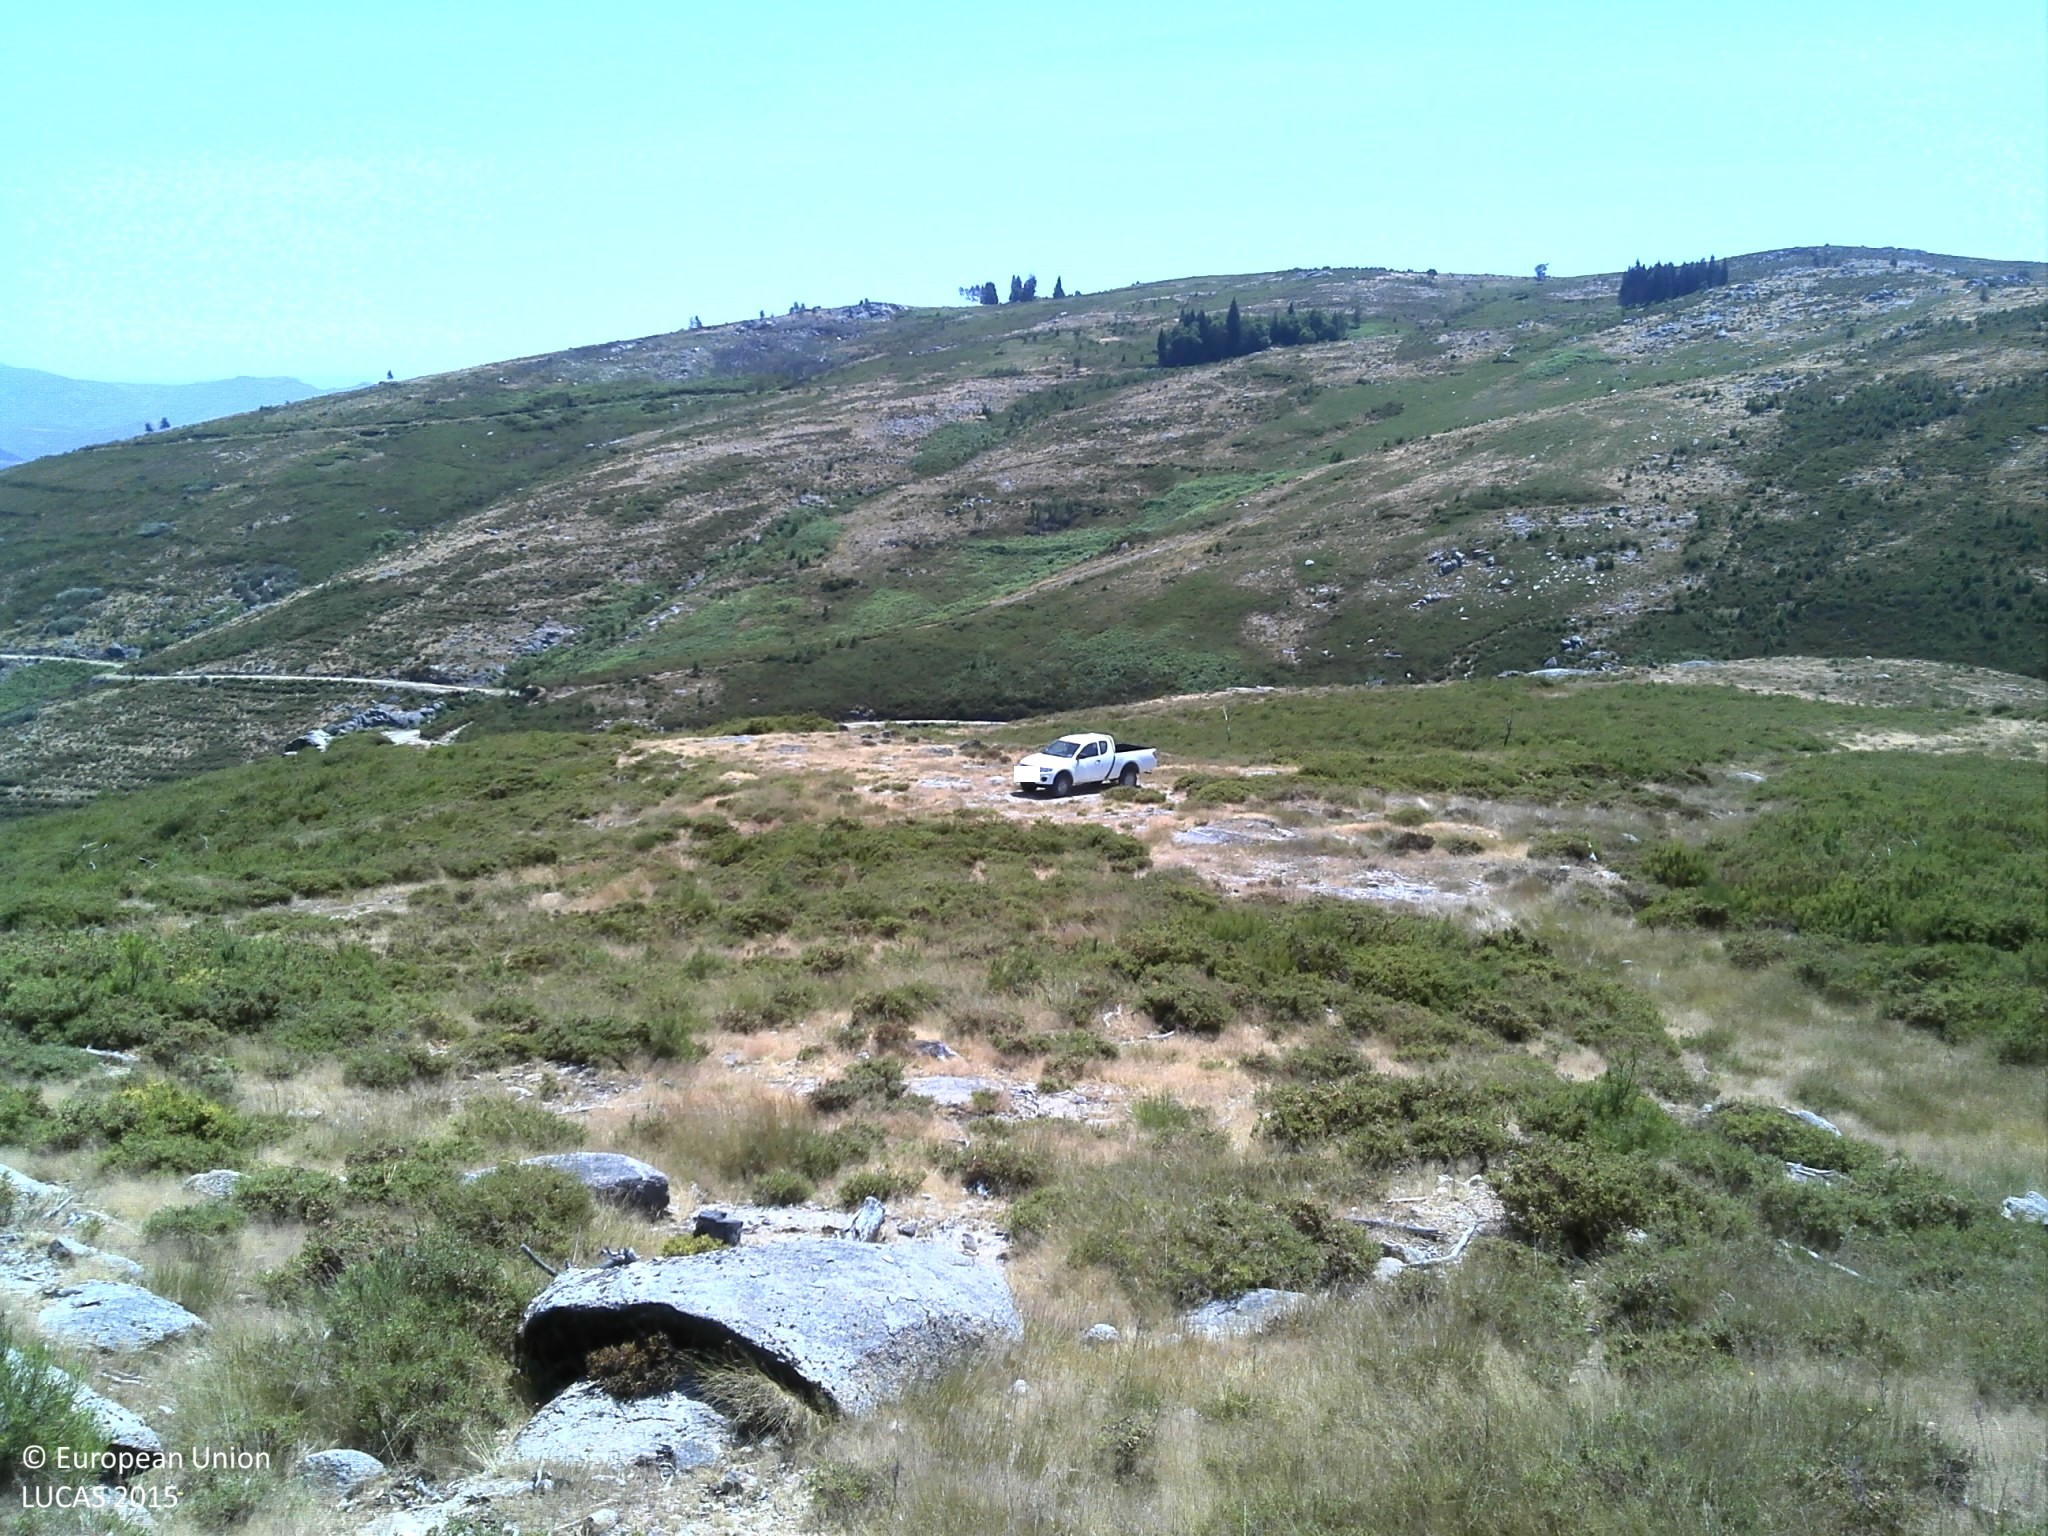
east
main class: Shrubland
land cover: Shrubland without tree cover
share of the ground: 50 - 75 %
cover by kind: shrubs 75 %, unconsolidated bare surface 20 %, consolidated bare surface 5 %
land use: Agriculture (excluding fallow land and kitchen gardens)
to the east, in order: Shrubland without tree cover; Rocks and stones; Shrubland without tree cover; Tracks; Shrubland without tree cover; Rocks and stones; Shrubland without tree cover; Rocks and stones; Tracks
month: July
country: PT
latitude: 41.5830
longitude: -7.8791
